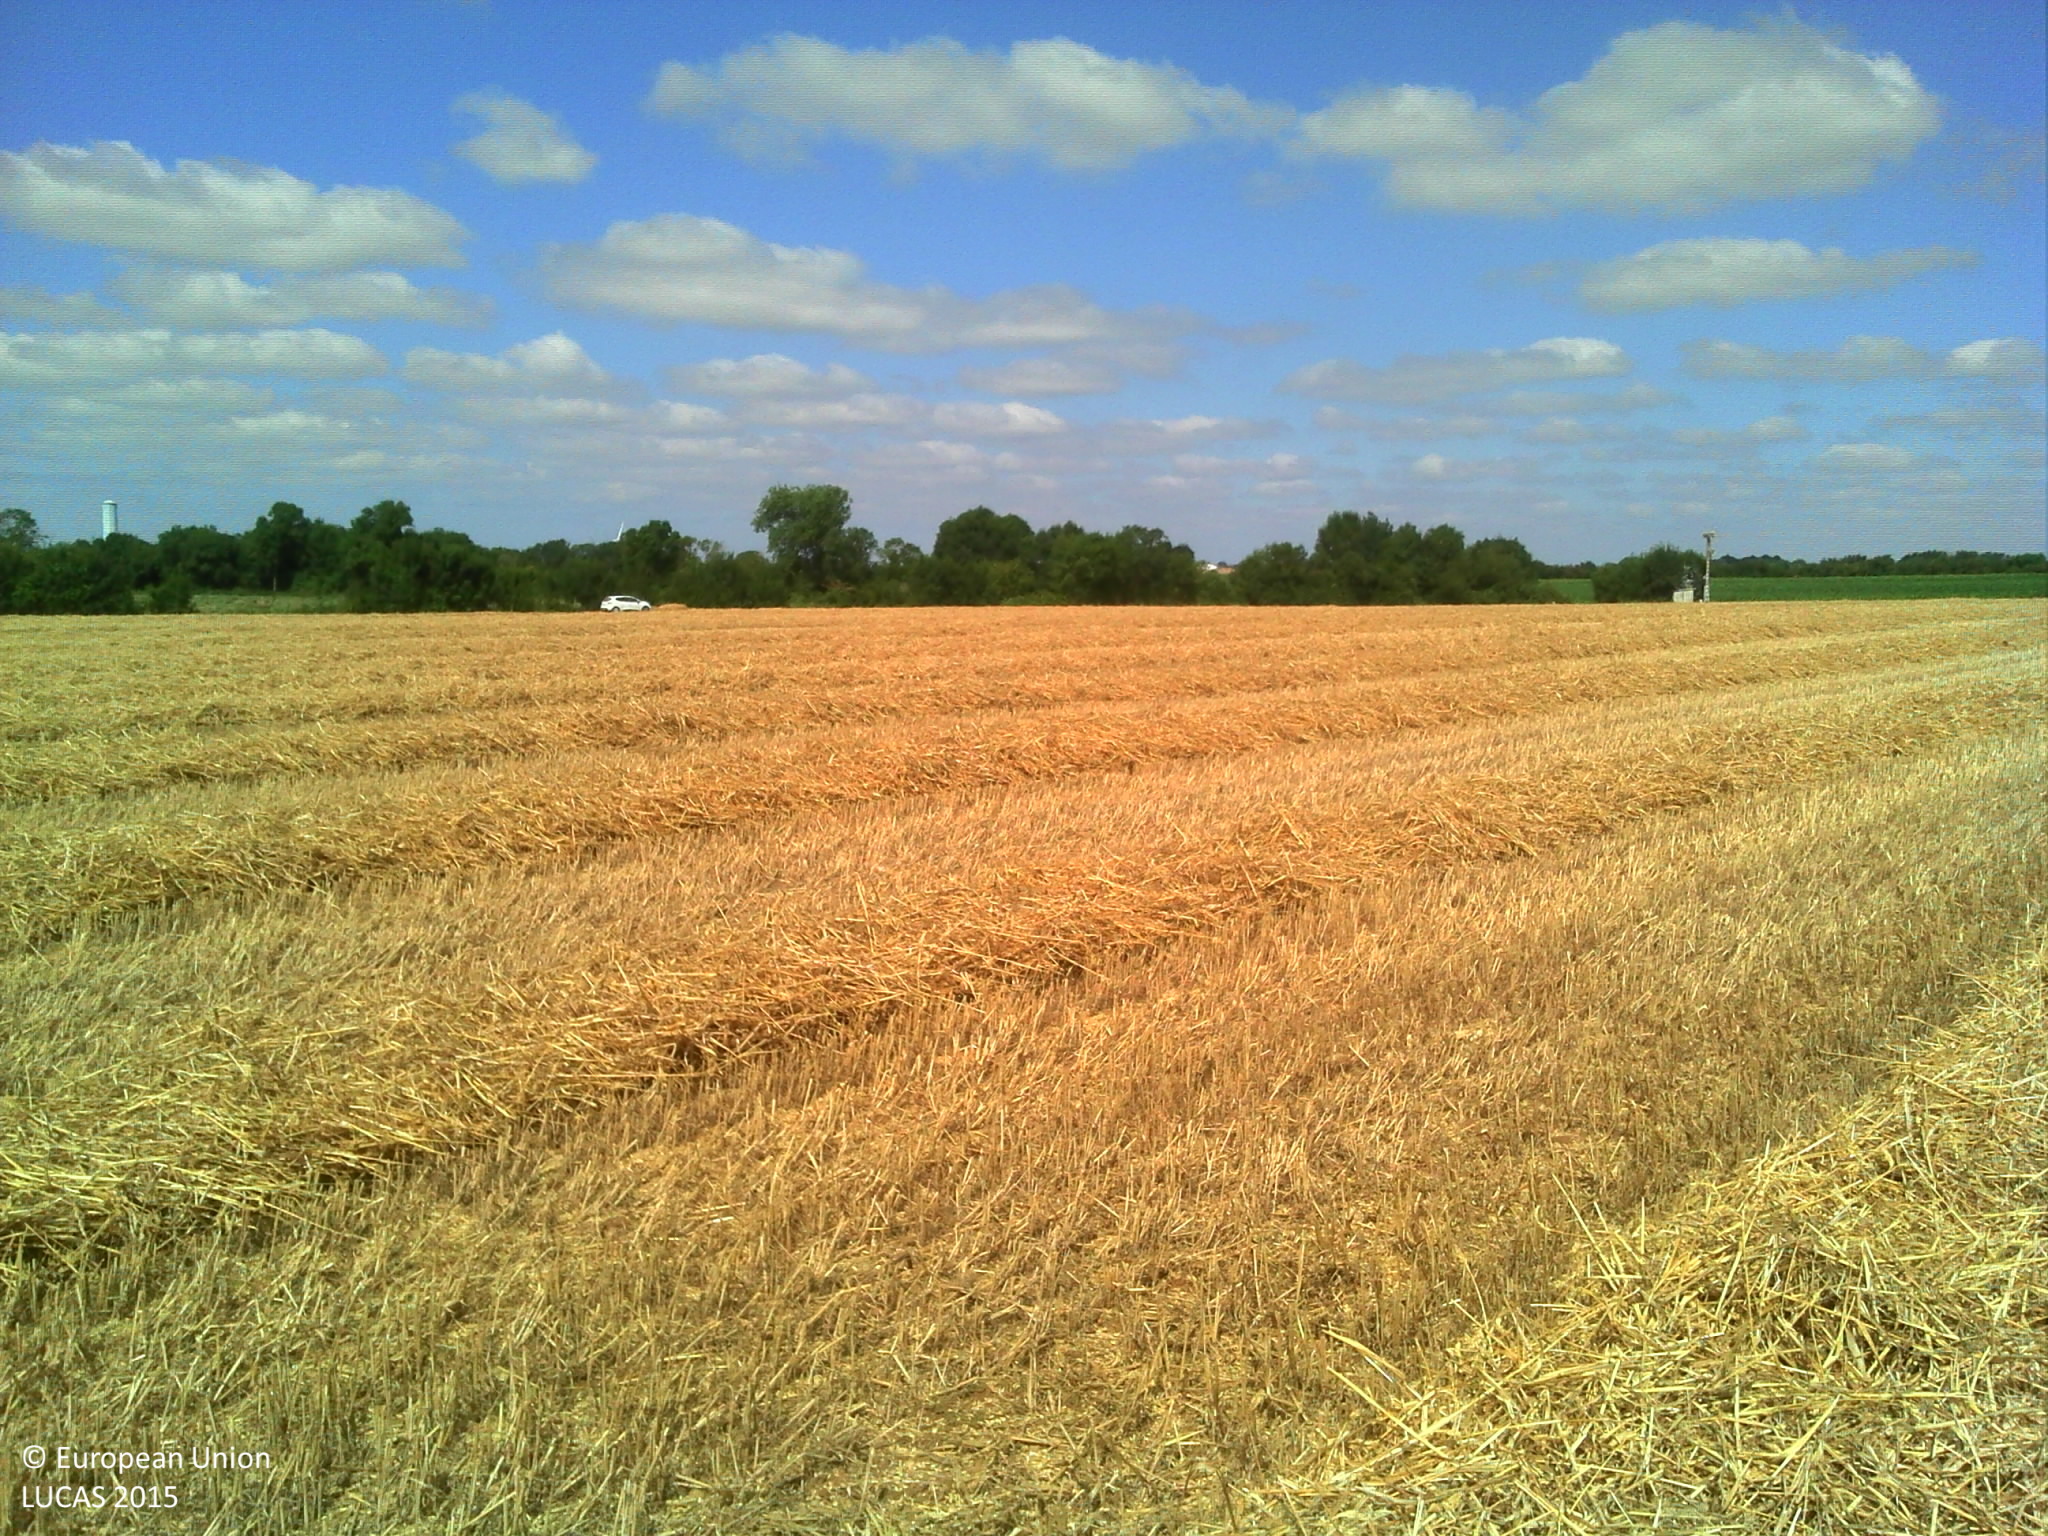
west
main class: Cropland
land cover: Common wheat
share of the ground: > 75 %
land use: Agriculture (excluding fallow land and kitchen gardens)
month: July
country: FR
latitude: 46.4158
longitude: -1.3676
